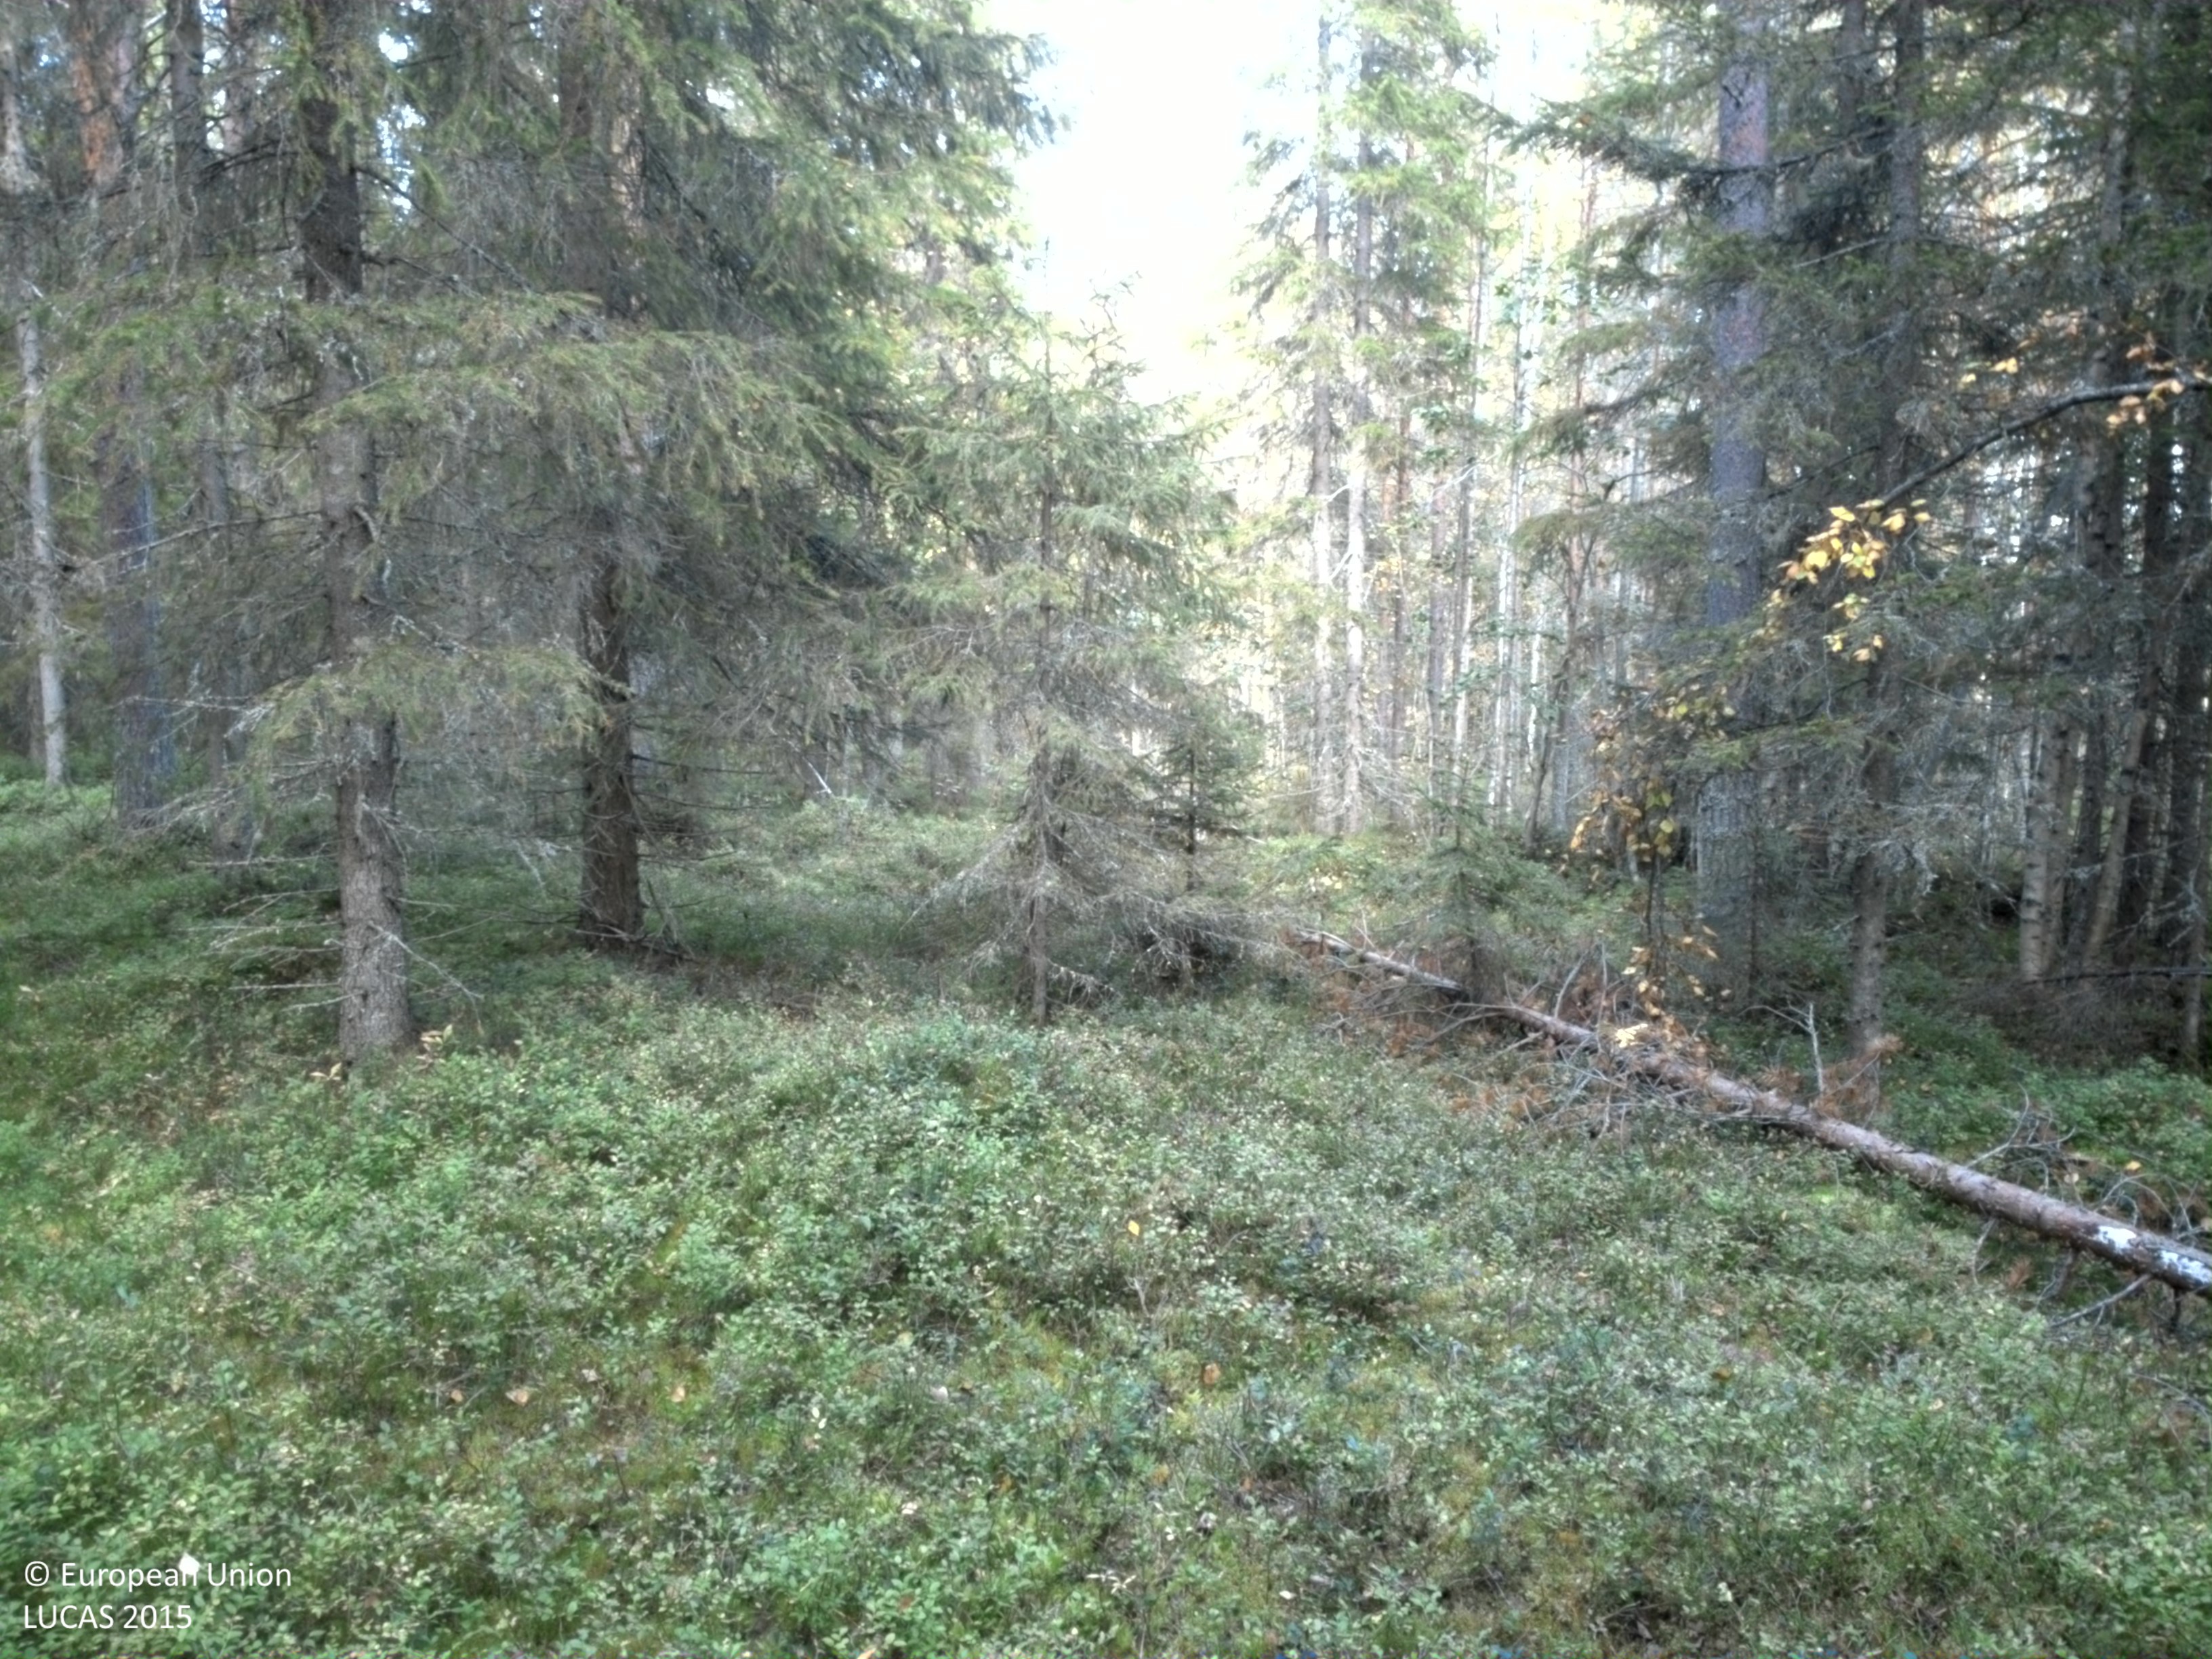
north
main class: Woodland
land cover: Spruce dominated coniferous woodland
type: boreal forest
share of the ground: 25 - 50 %
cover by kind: shrubs 50 %, coniferous forest trees 40 %, lichens and mosses 10 %
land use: Forestry
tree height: > 5 m
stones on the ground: < 10 %
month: September
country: SE
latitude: 65.5097
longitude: 21.8464
